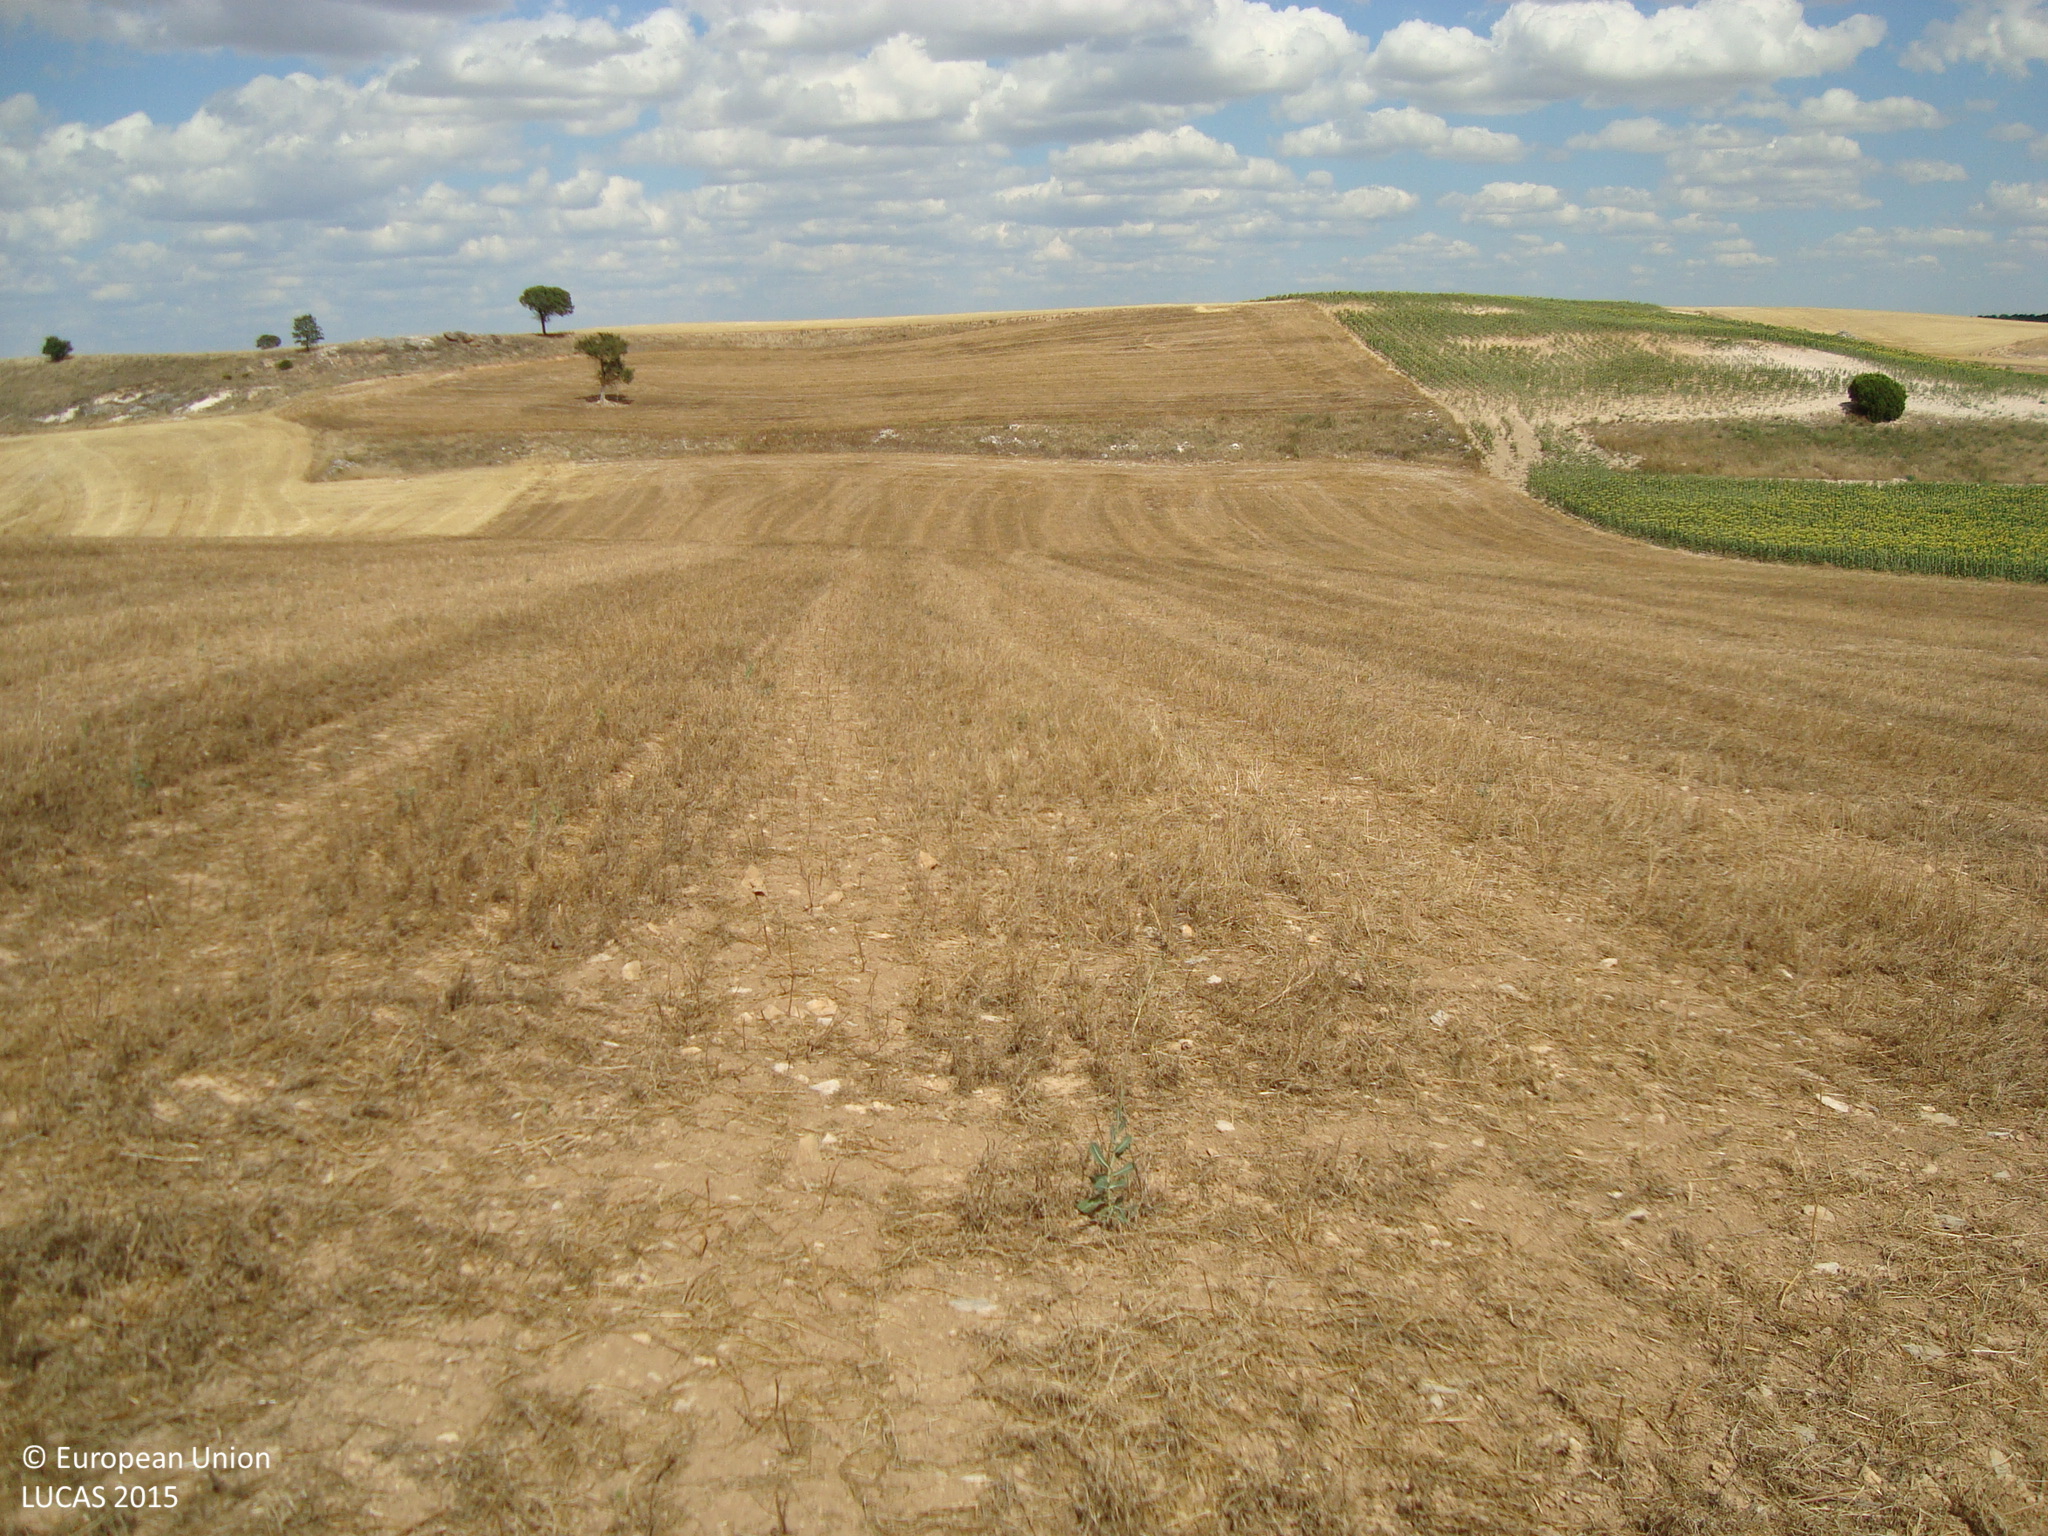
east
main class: Cropland
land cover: Dry pulses
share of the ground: > 75 %
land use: Agriculture (excluding fallow land and kitchen gardens)
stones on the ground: < 10 %
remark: Harvested field
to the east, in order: Dry pulses; Sunflower
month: July
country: ES
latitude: 41.9328
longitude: -3.8673
